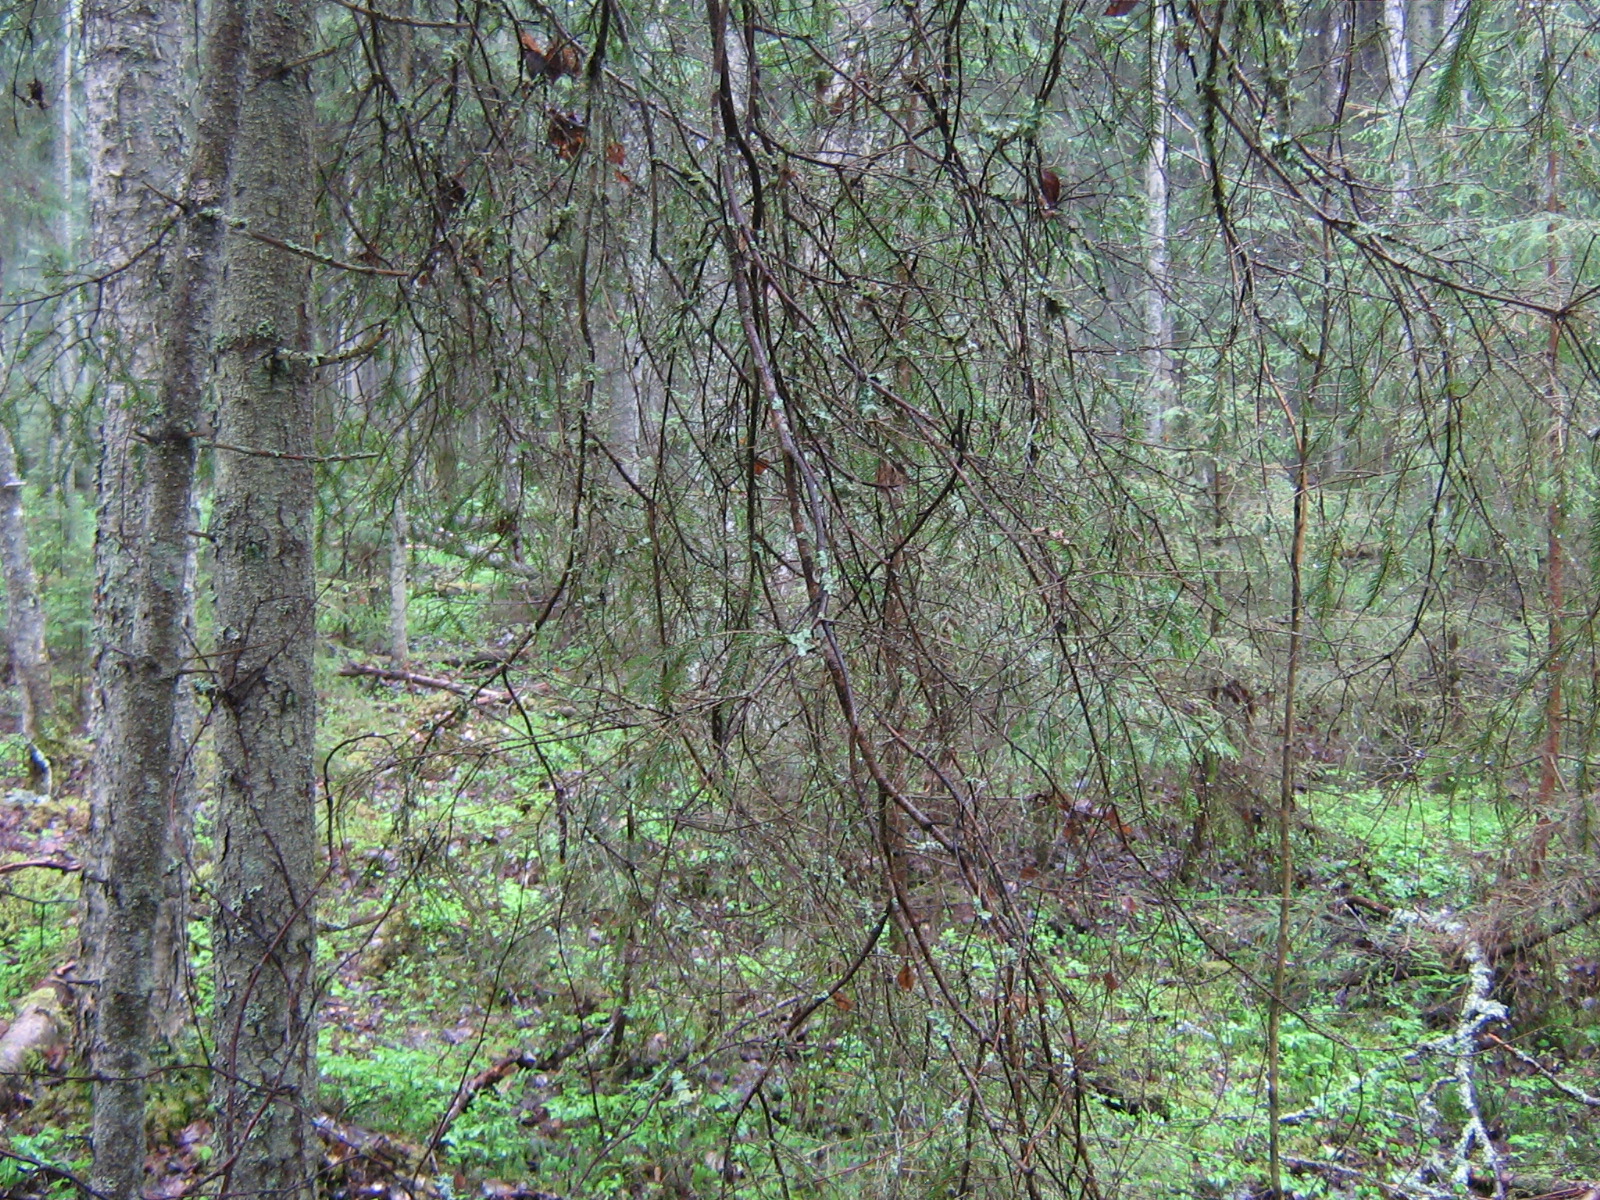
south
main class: Woodland
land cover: Spruce dominated mixed woodland
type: boreal forest
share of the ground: > 75 %
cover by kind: coniferous forest trees 75 %, broadleaved forest trees 25 %
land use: Forestry
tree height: > 5 m
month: May
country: LV
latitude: 57.2912
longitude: 25.9747
